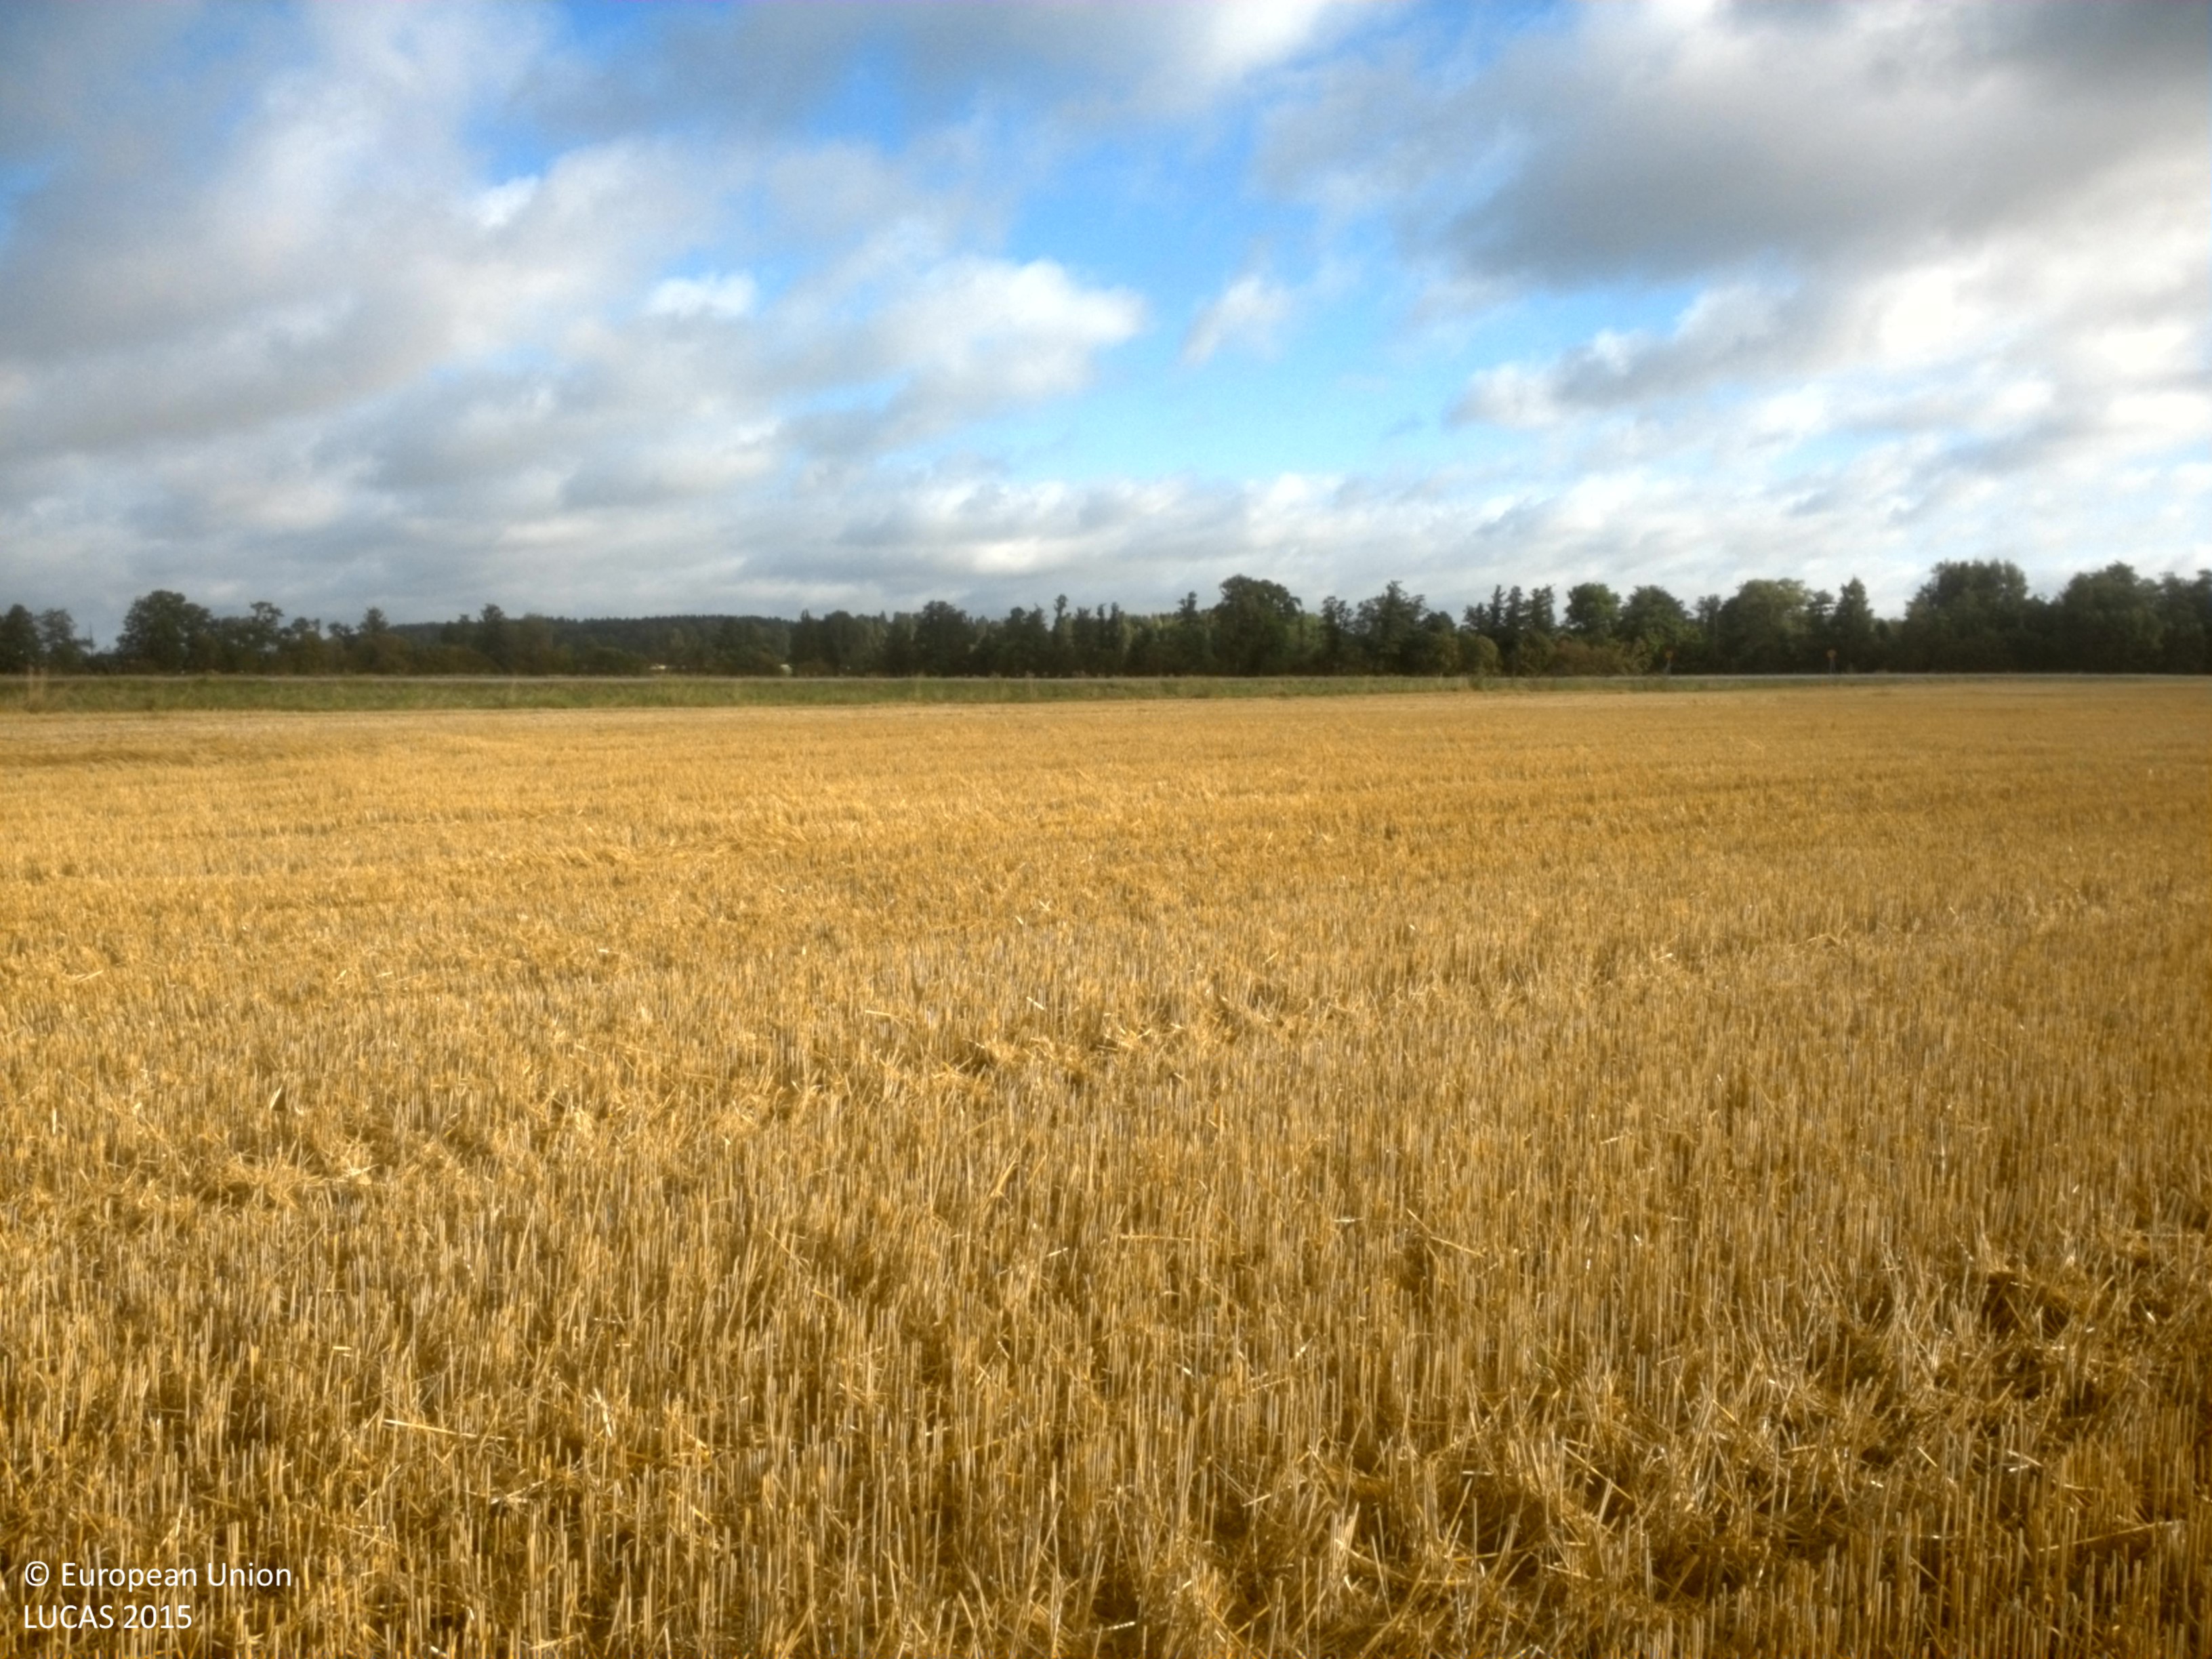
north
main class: Cropland
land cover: Common wheat
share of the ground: > 75 %
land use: Agriculture (excluding fallow land and kitchen gardens)
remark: Harvested field
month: August
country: SE
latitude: 59.5151
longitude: 15.9116
